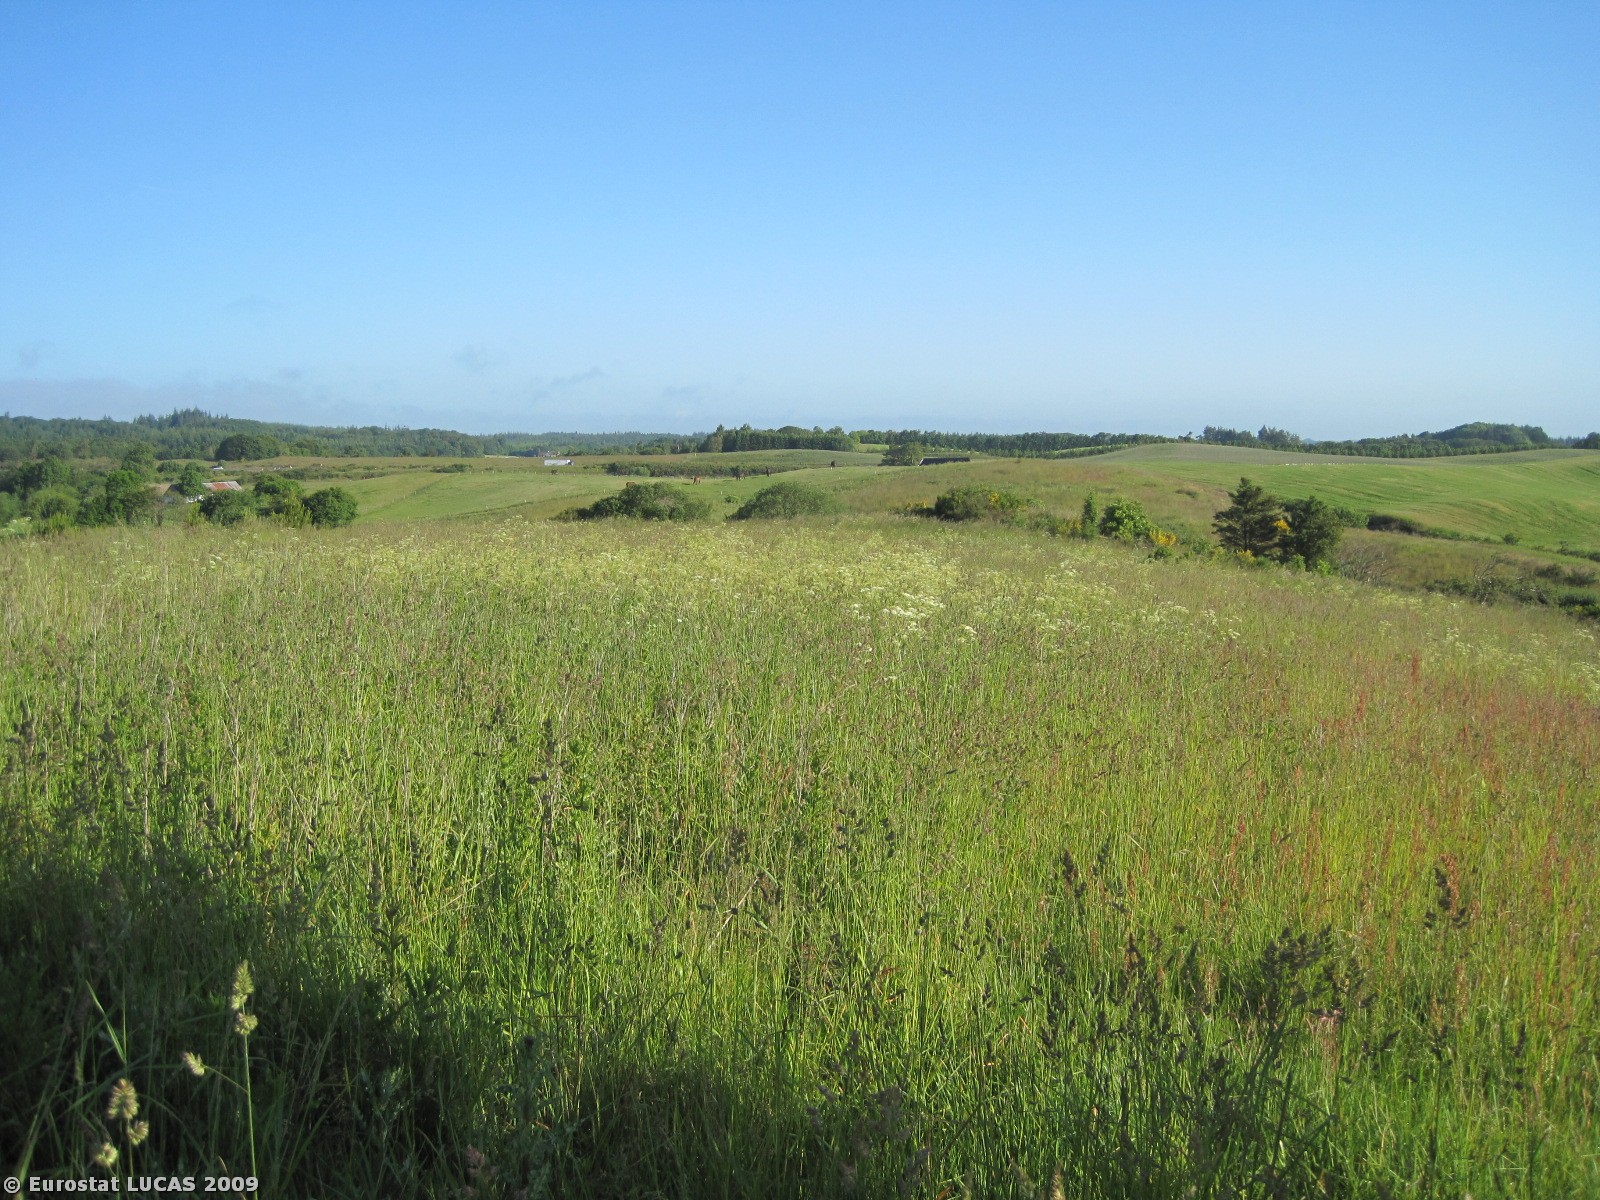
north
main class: Grassland
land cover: Grassland without tree/shrub cover
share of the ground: > 75 %
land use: Unused
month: June
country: DK
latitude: 57.2302
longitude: 10.2481
